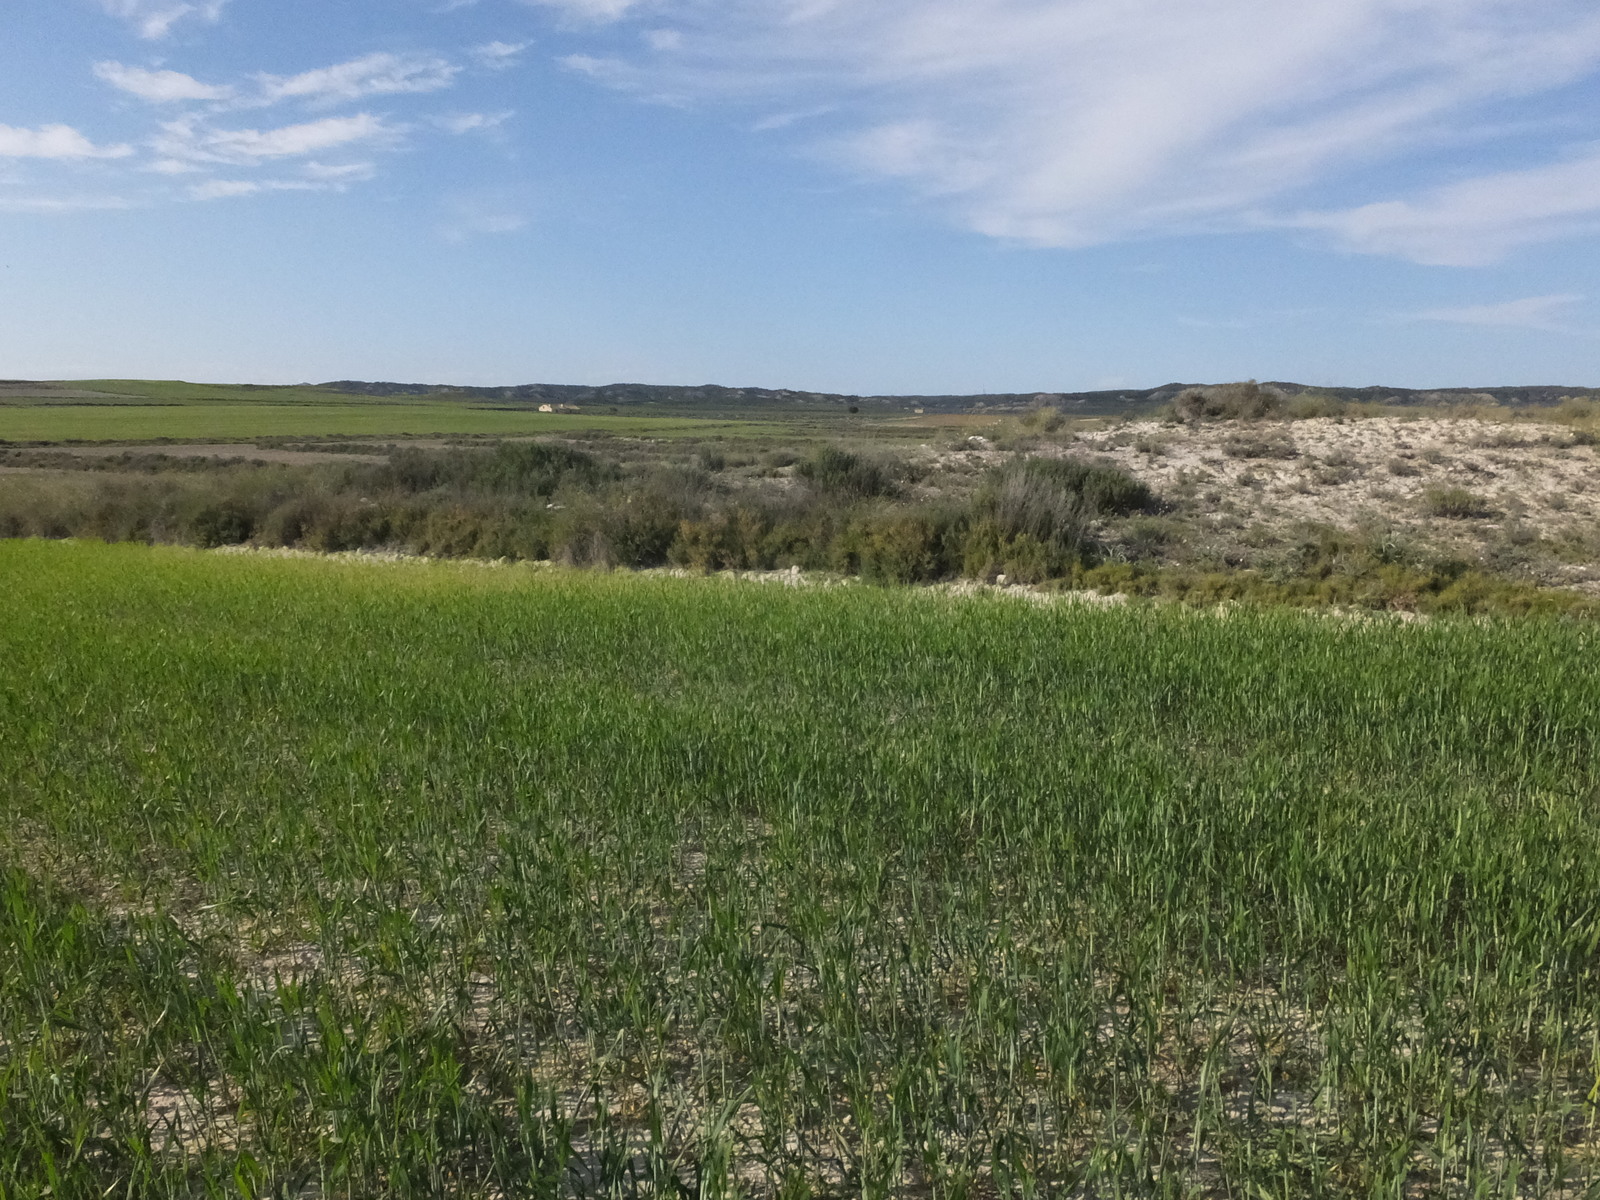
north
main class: Cropland
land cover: Common wheat
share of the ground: > 75 %
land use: Agriculture (excluding fallow land and kitchen gardens)
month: April
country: ES
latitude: 41.5617
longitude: -0.3172
